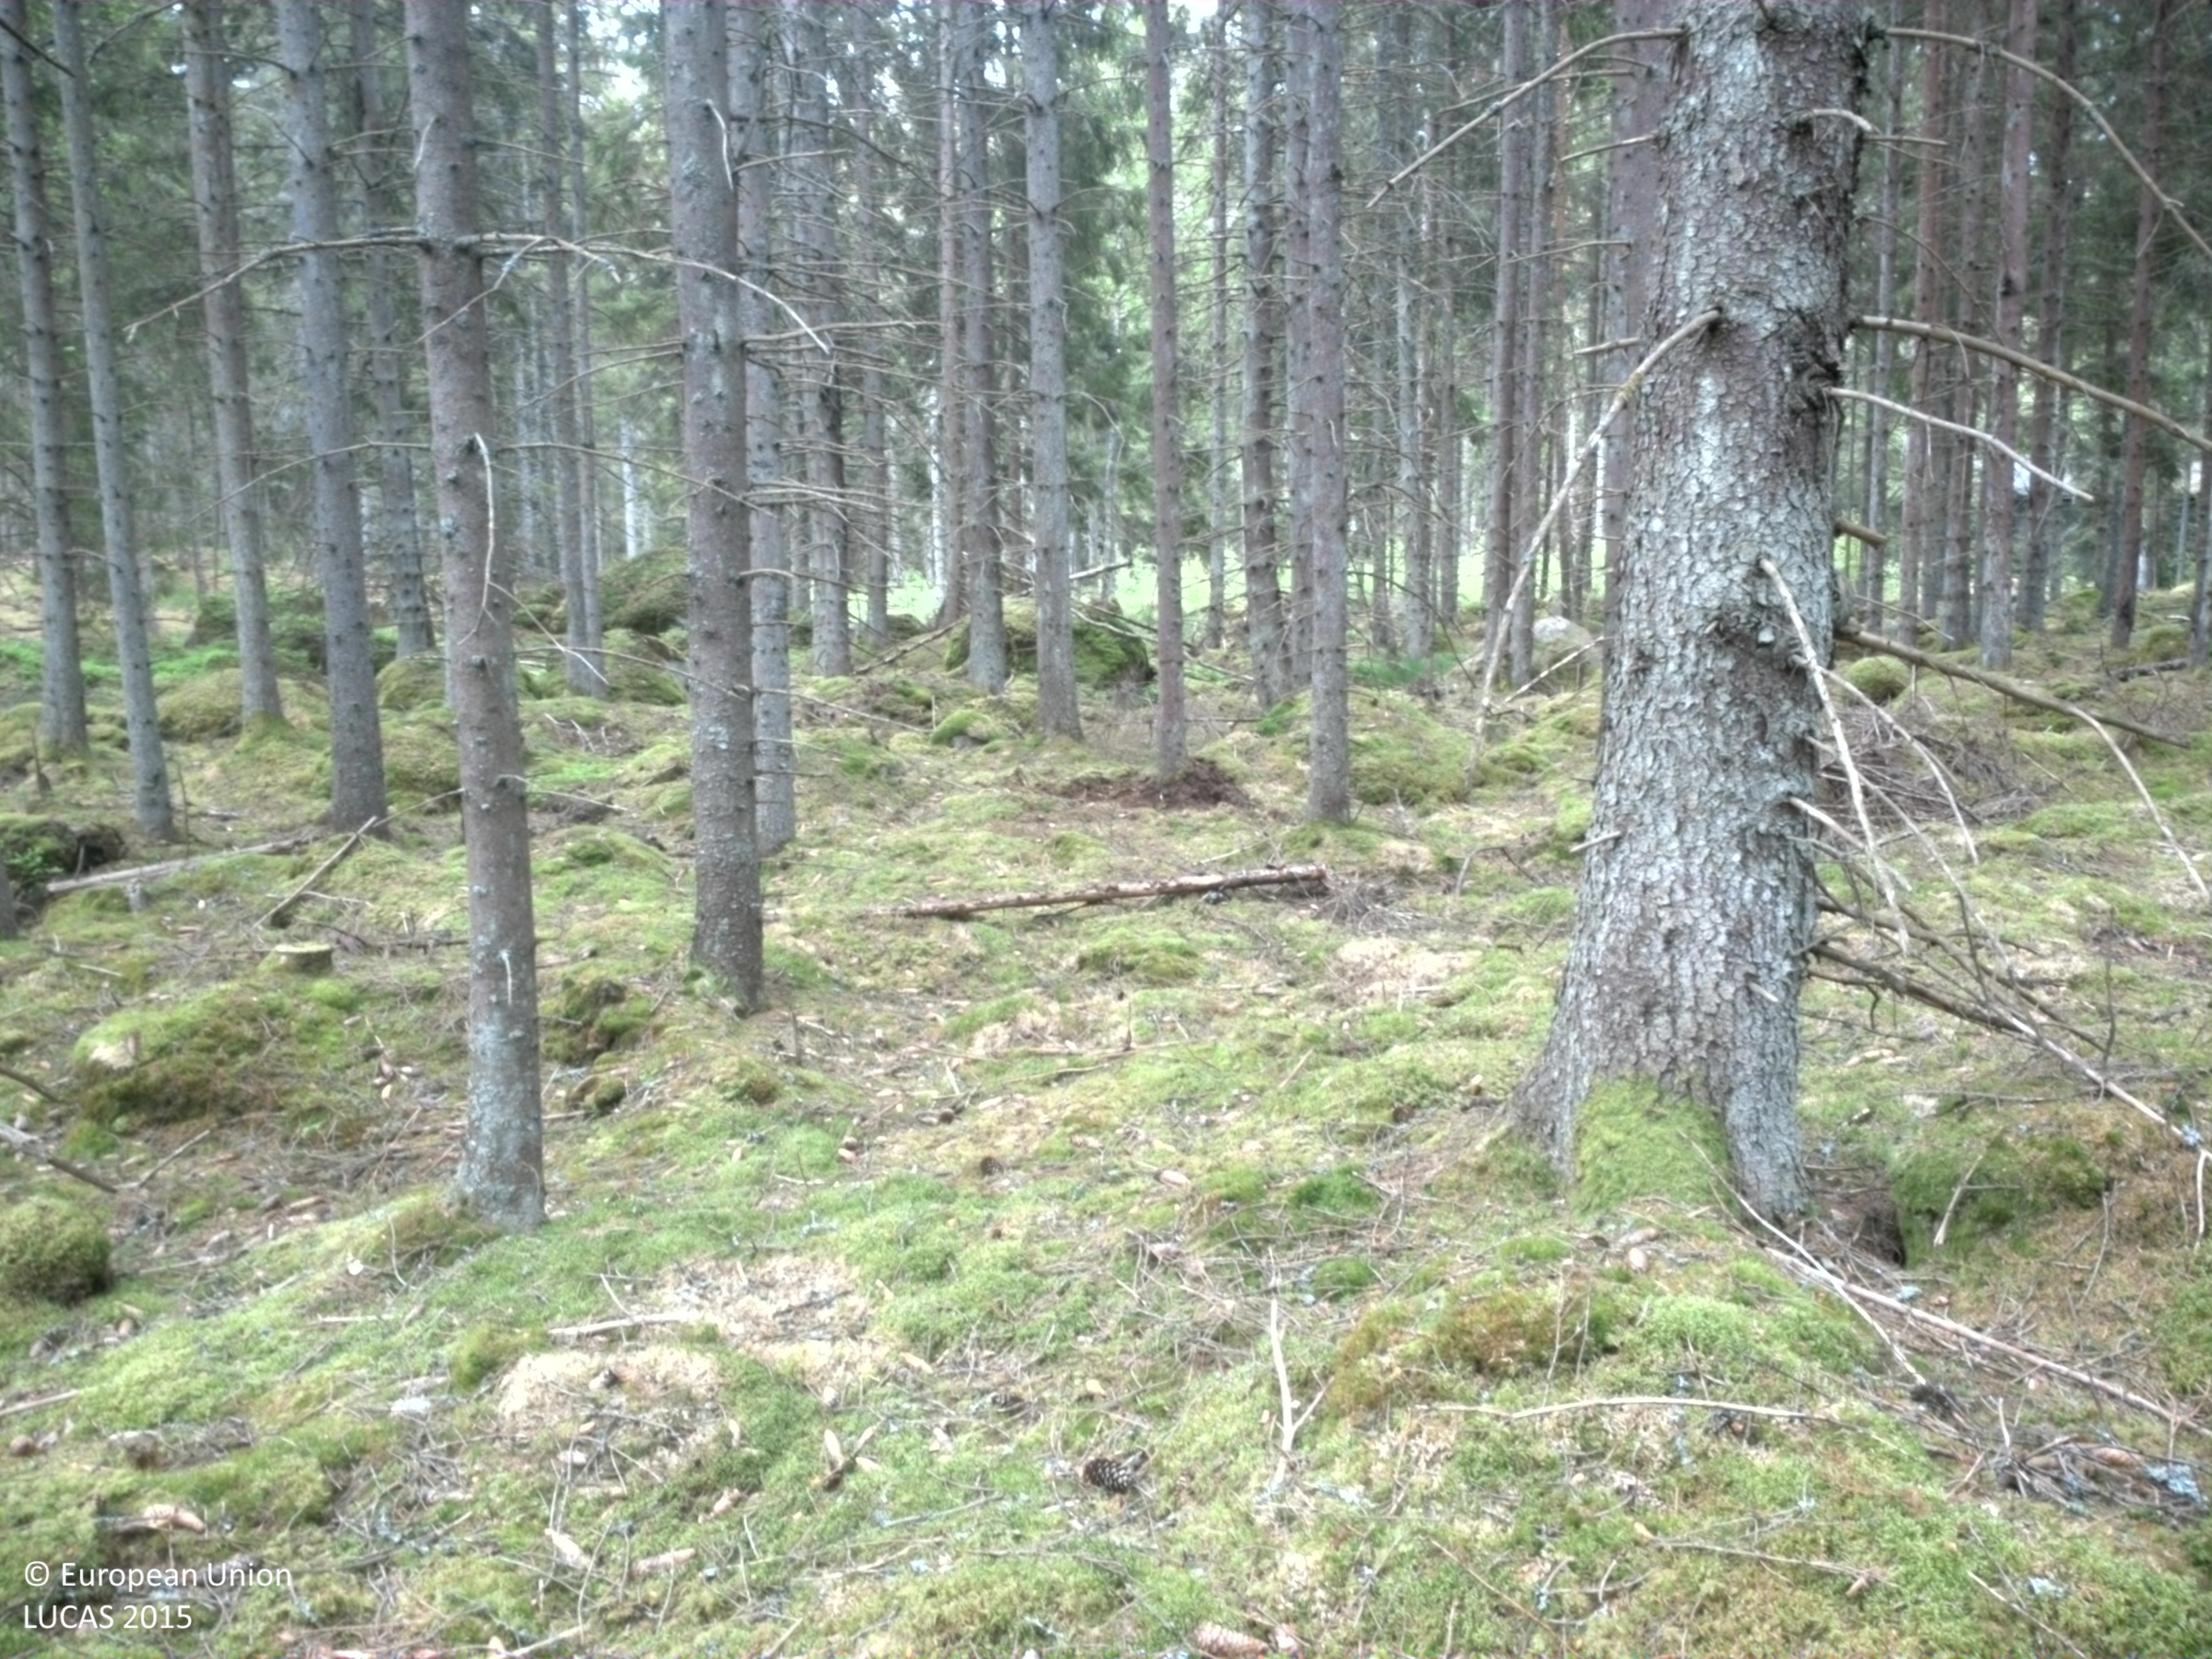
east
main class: Woodland
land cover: Spruce dominated coniferous woodland
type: boreal forest
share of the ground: > 75 %
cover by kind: coniferous forest trees 85 %, lichens and mosses 10 %, broadleaved forest trees 5 %
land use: Forestry
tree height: > 5 m
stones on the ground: < 10 %
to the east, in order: Spruce dominated coniferous woodland; Rivers and streams; Spruce dominated coniferous woodland; Paved roads, cycling and walking lanes; Spruce dominated coniferous woodland; Ditches and canals; Spruce dominated coniferous woodland; Spruce dominated mixed woodland; Ditches and canals; Spruce dominated coniferous woodland
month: May
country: SE
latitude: 56.5540
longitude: 15.1228
